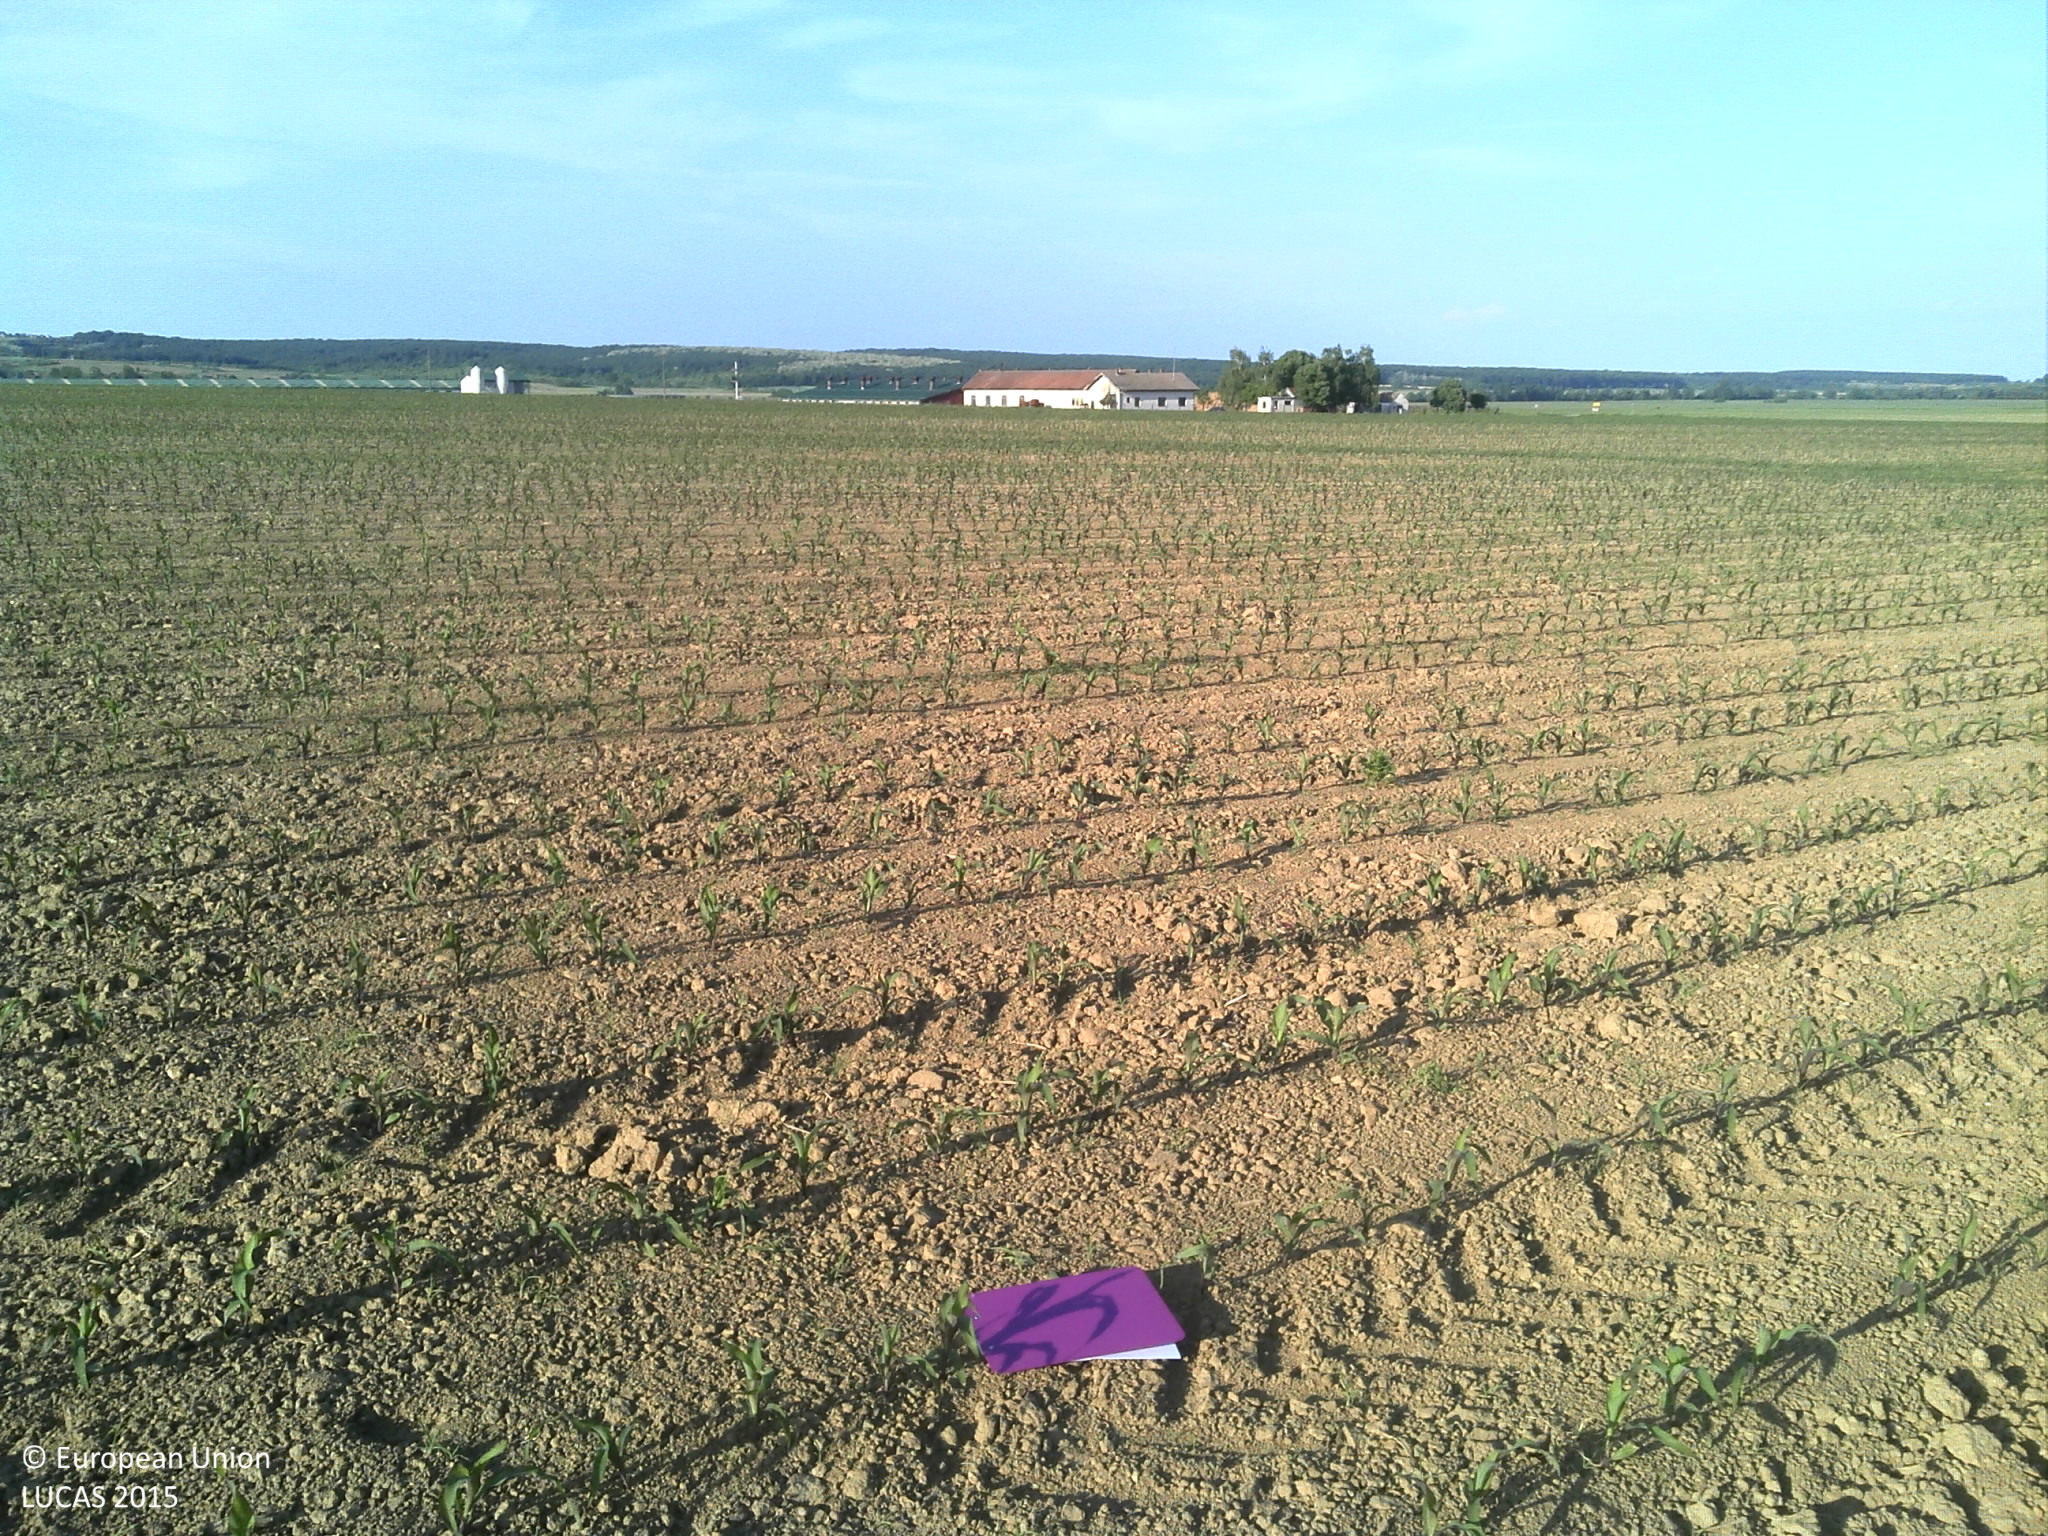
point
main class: Cropland
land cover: Maize
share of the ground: < 10 %
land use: Agriculture (excluding fallow land and kitchen gardens)
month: May
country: HR
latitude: 45.2358
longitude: 18.2455
